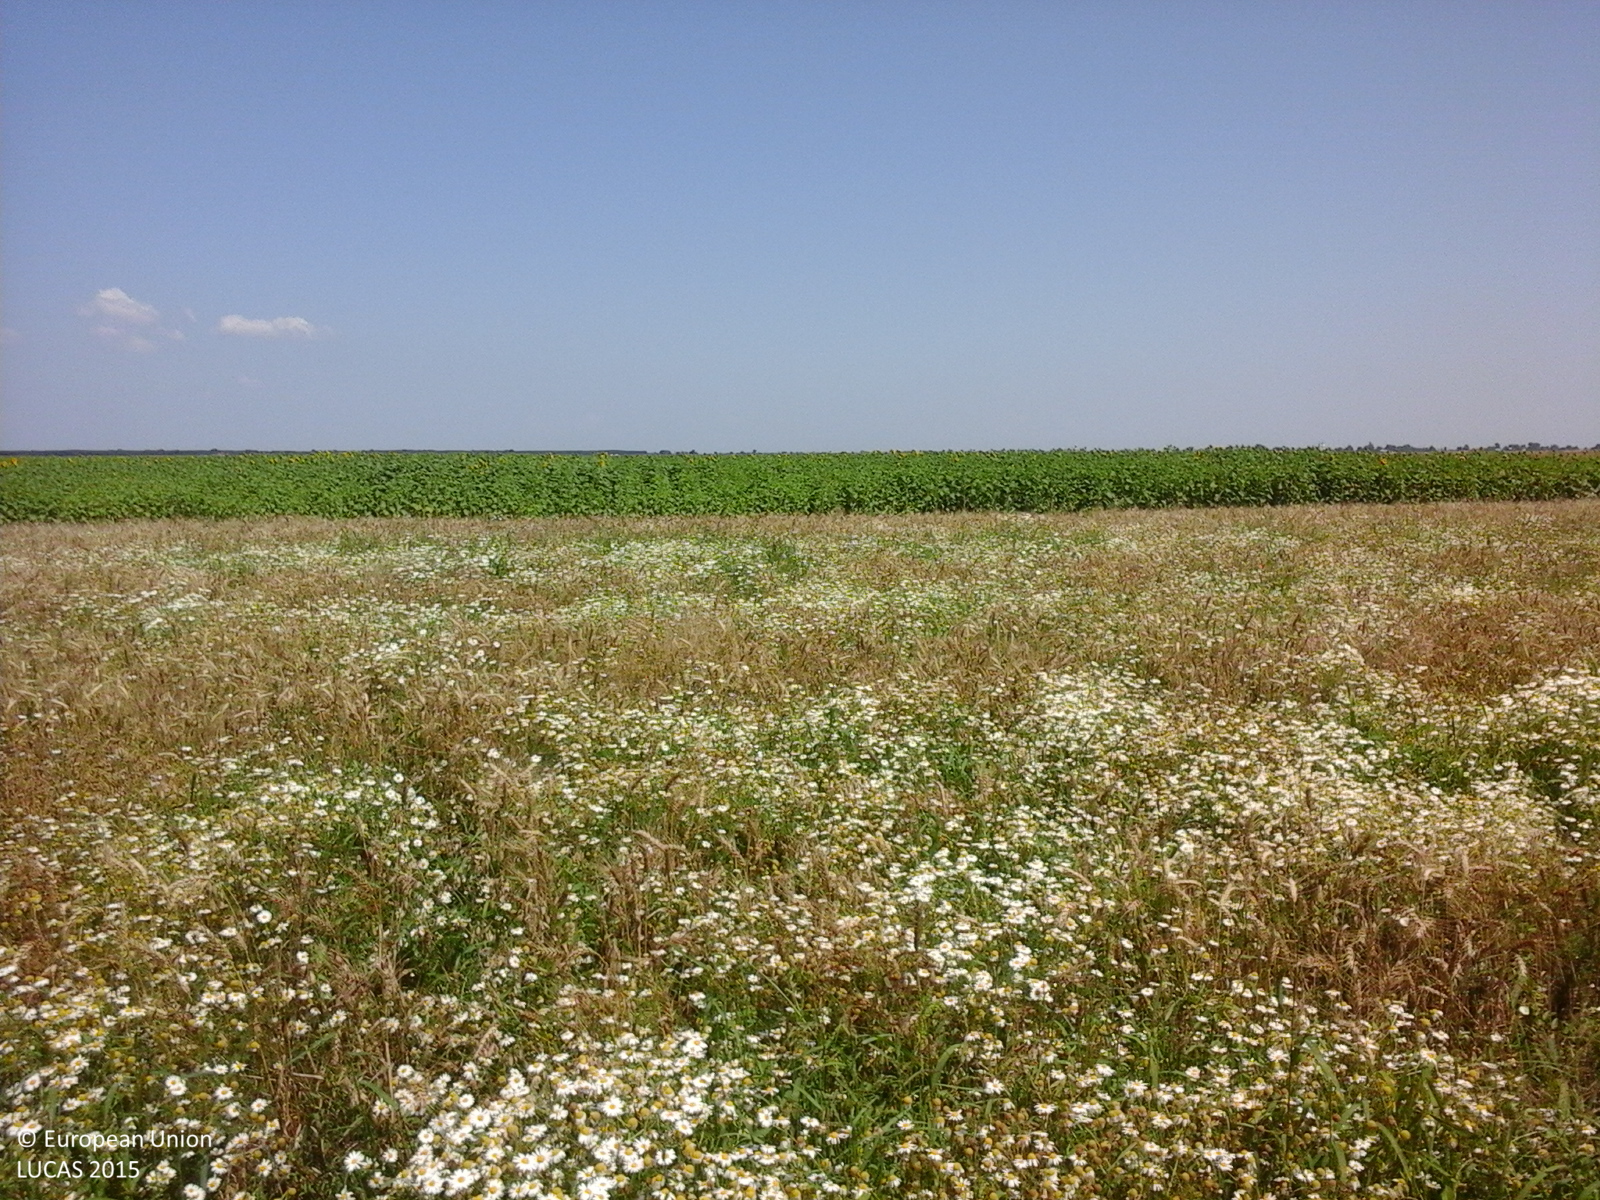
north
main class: Cropland
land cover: Common wheat
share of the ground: > 75 %
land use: Agriculture (excluding fallow land and kitchen gardens)
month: July
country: RO
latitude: 44.4199
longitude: 24.5272
